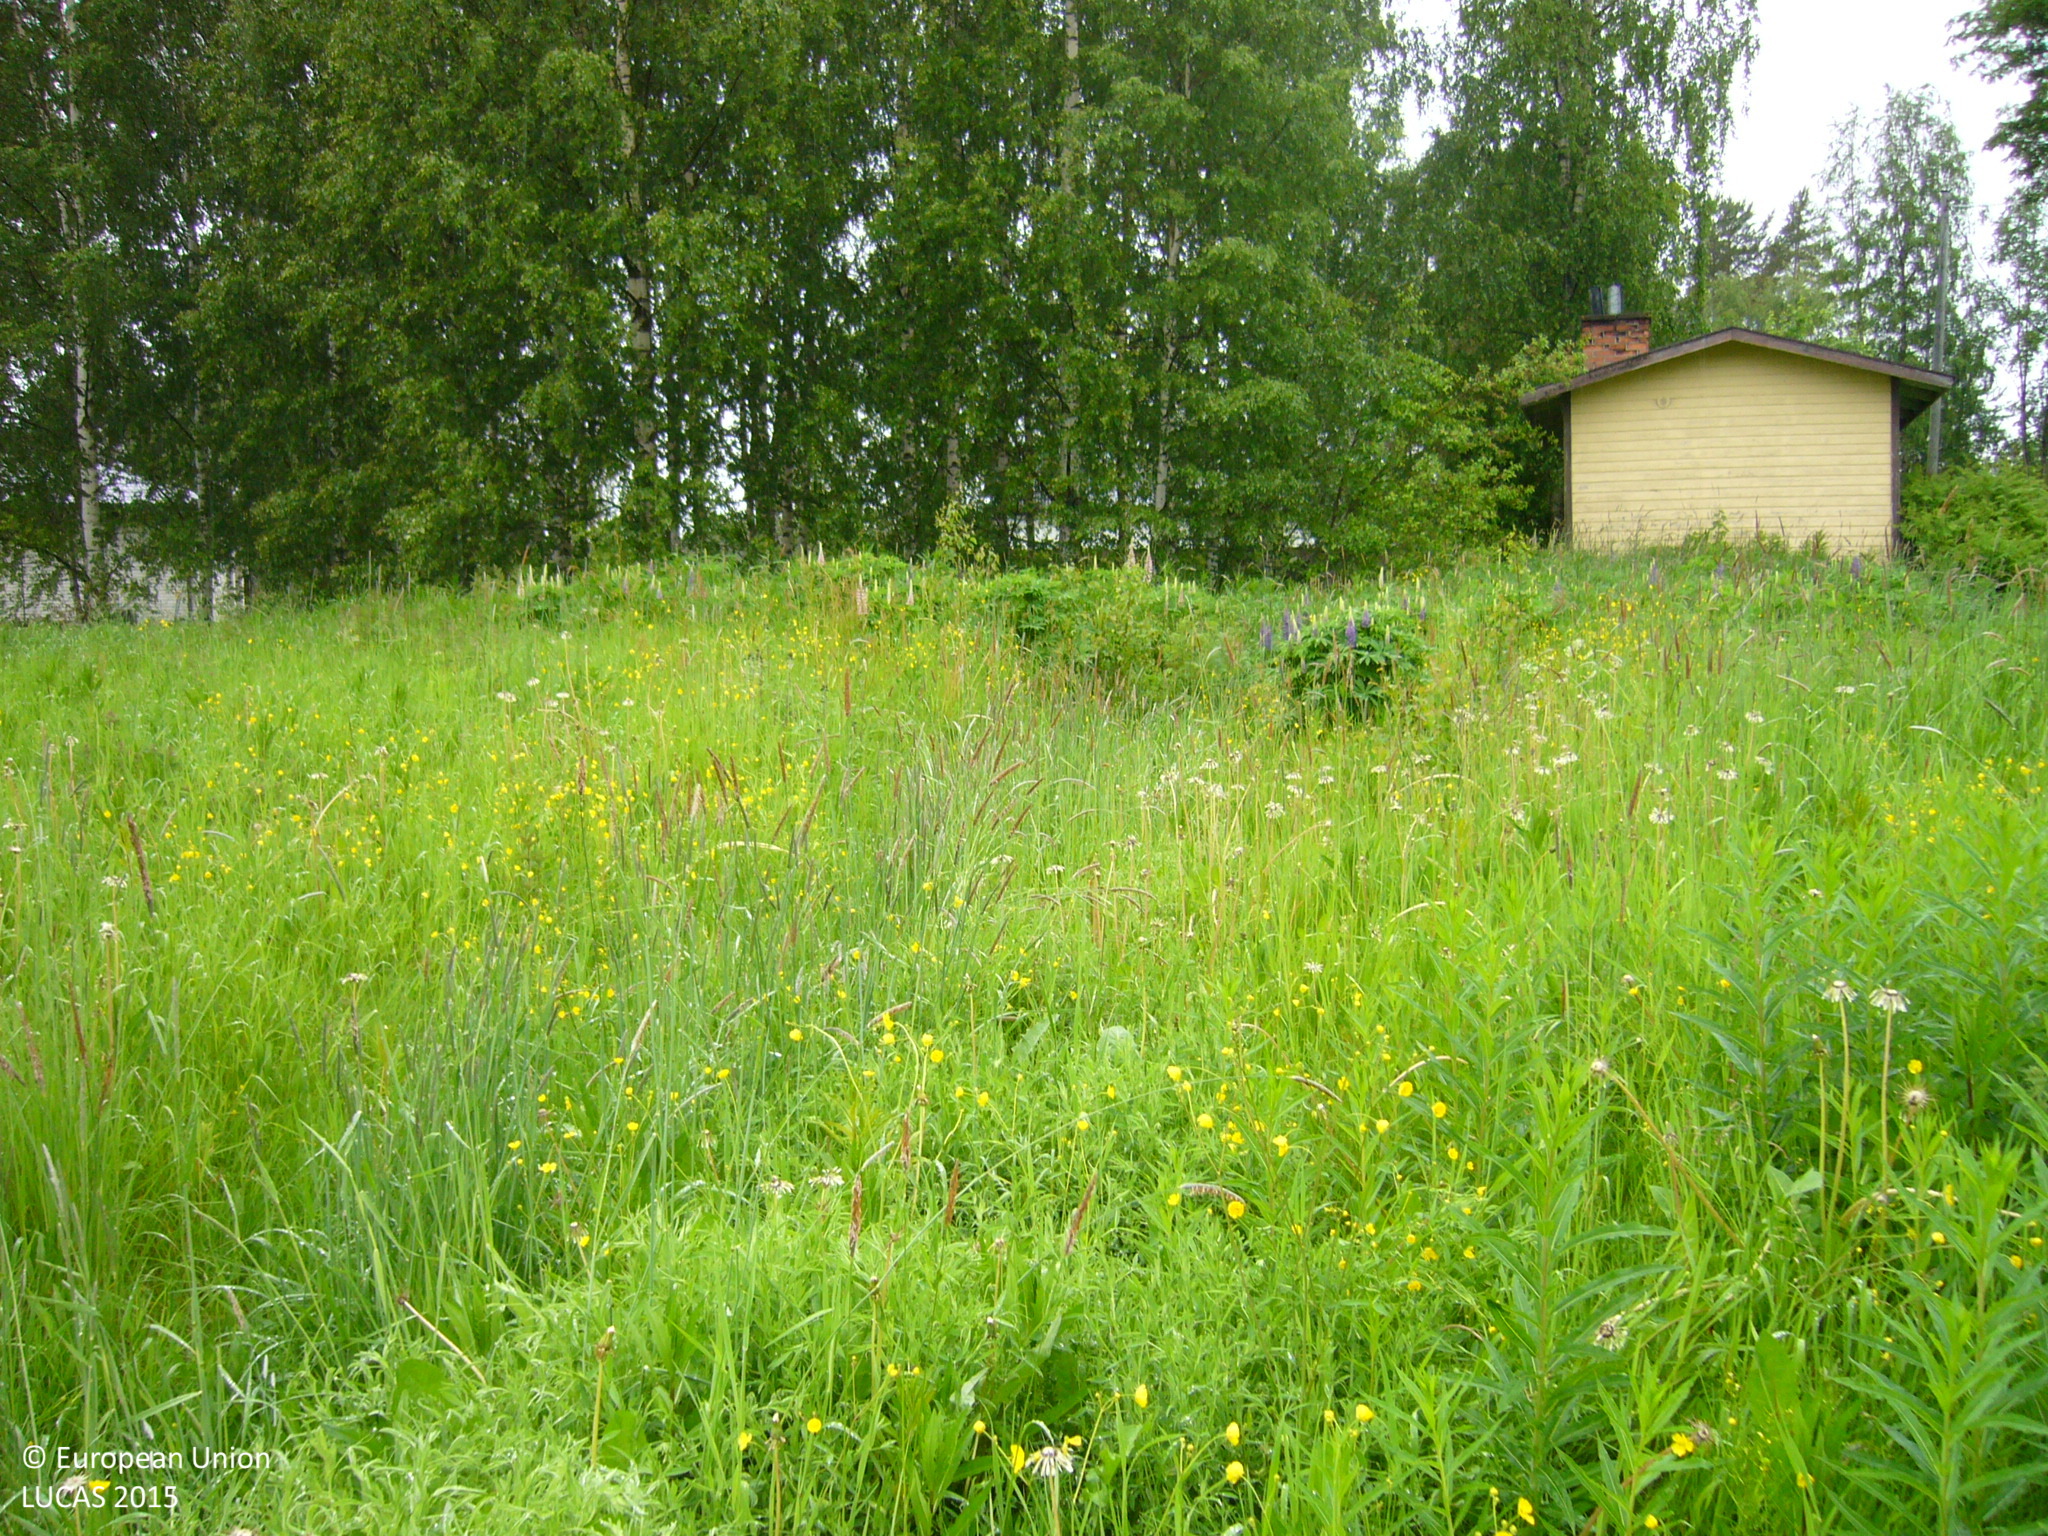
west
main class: Grassland
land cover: Grassland without tree/shrub cover
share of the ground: > 75 %
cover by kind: herbaceous plants 100 %
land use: Agriculture (excluding fallow land and kitchen gardens)
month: June
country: FI
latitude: 63.8309
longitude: 25.1493
